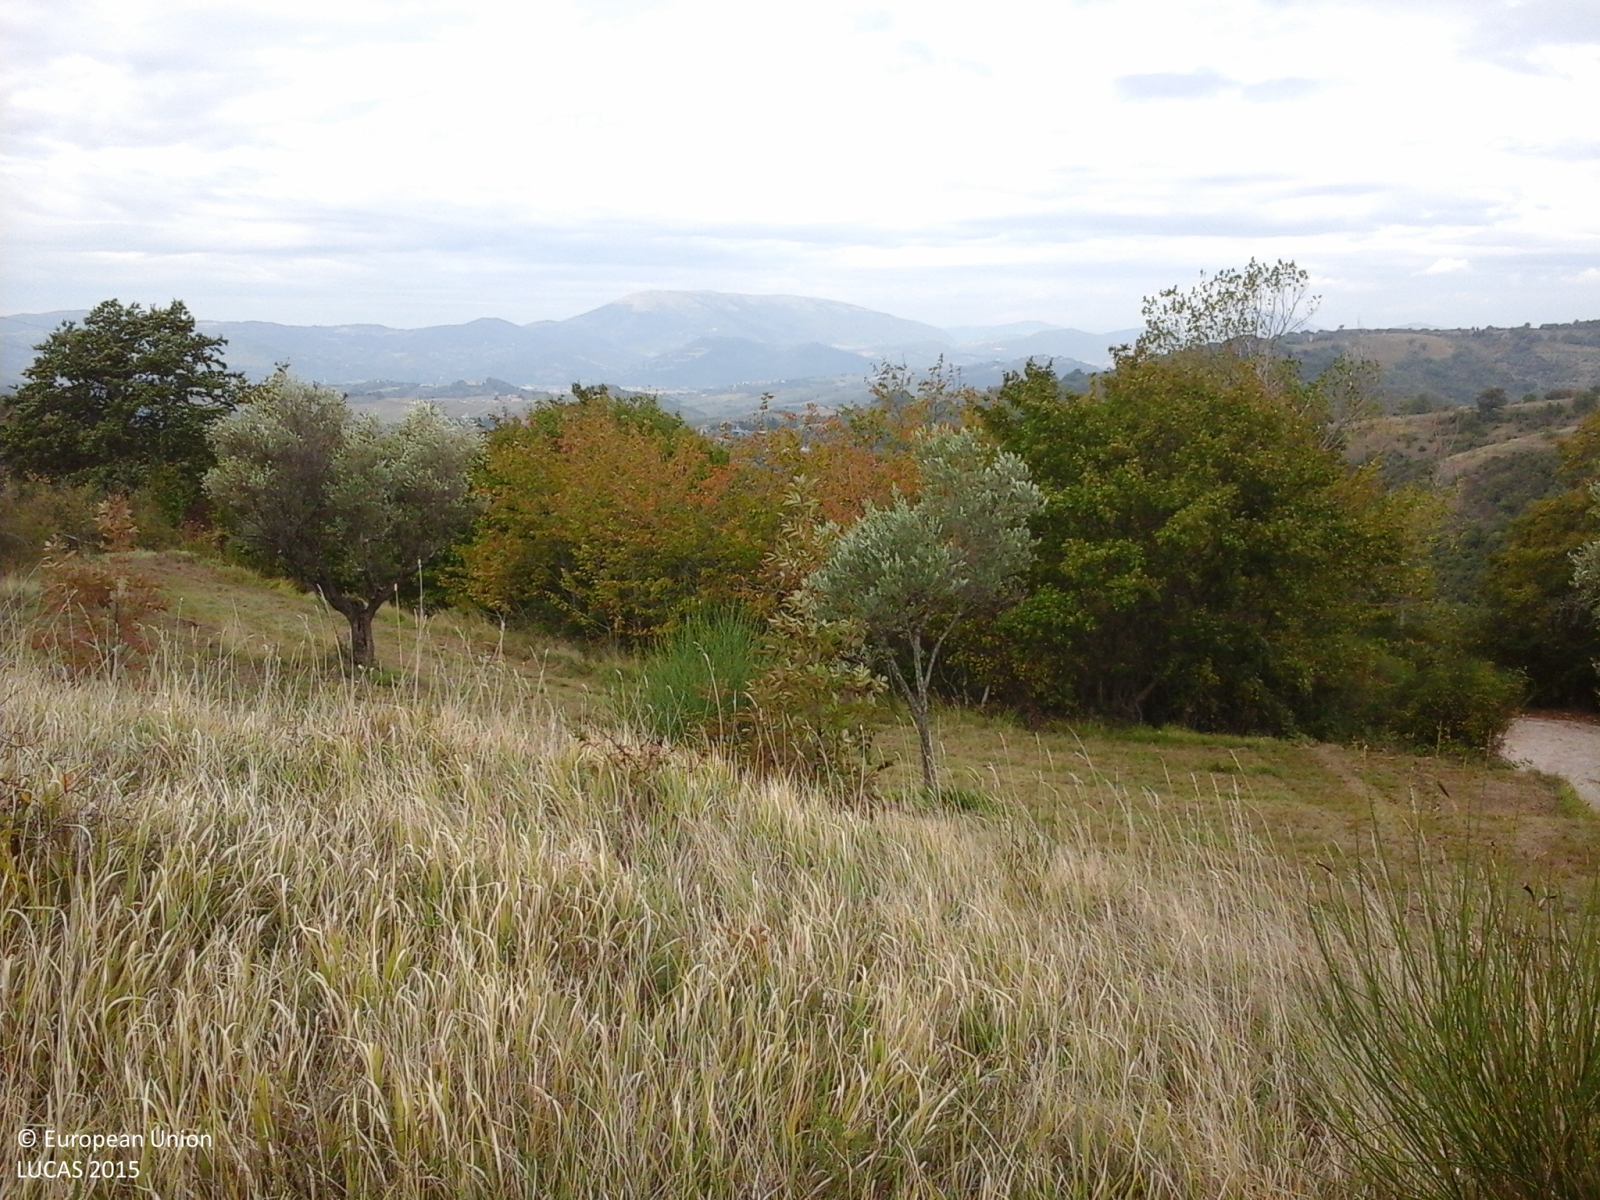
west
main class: Grassland
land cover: Grassland with sparse tree/shrub cover
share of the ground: > 75 %
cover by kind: herbaceous plants 85 %, shrubs 10 %, broadleaved forest trees 5 %
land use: Agriculture (excluding fallow land and kitchen gardens)
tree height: > 5 m
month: October
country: IT
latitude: 43.1822
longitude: 12.5396
